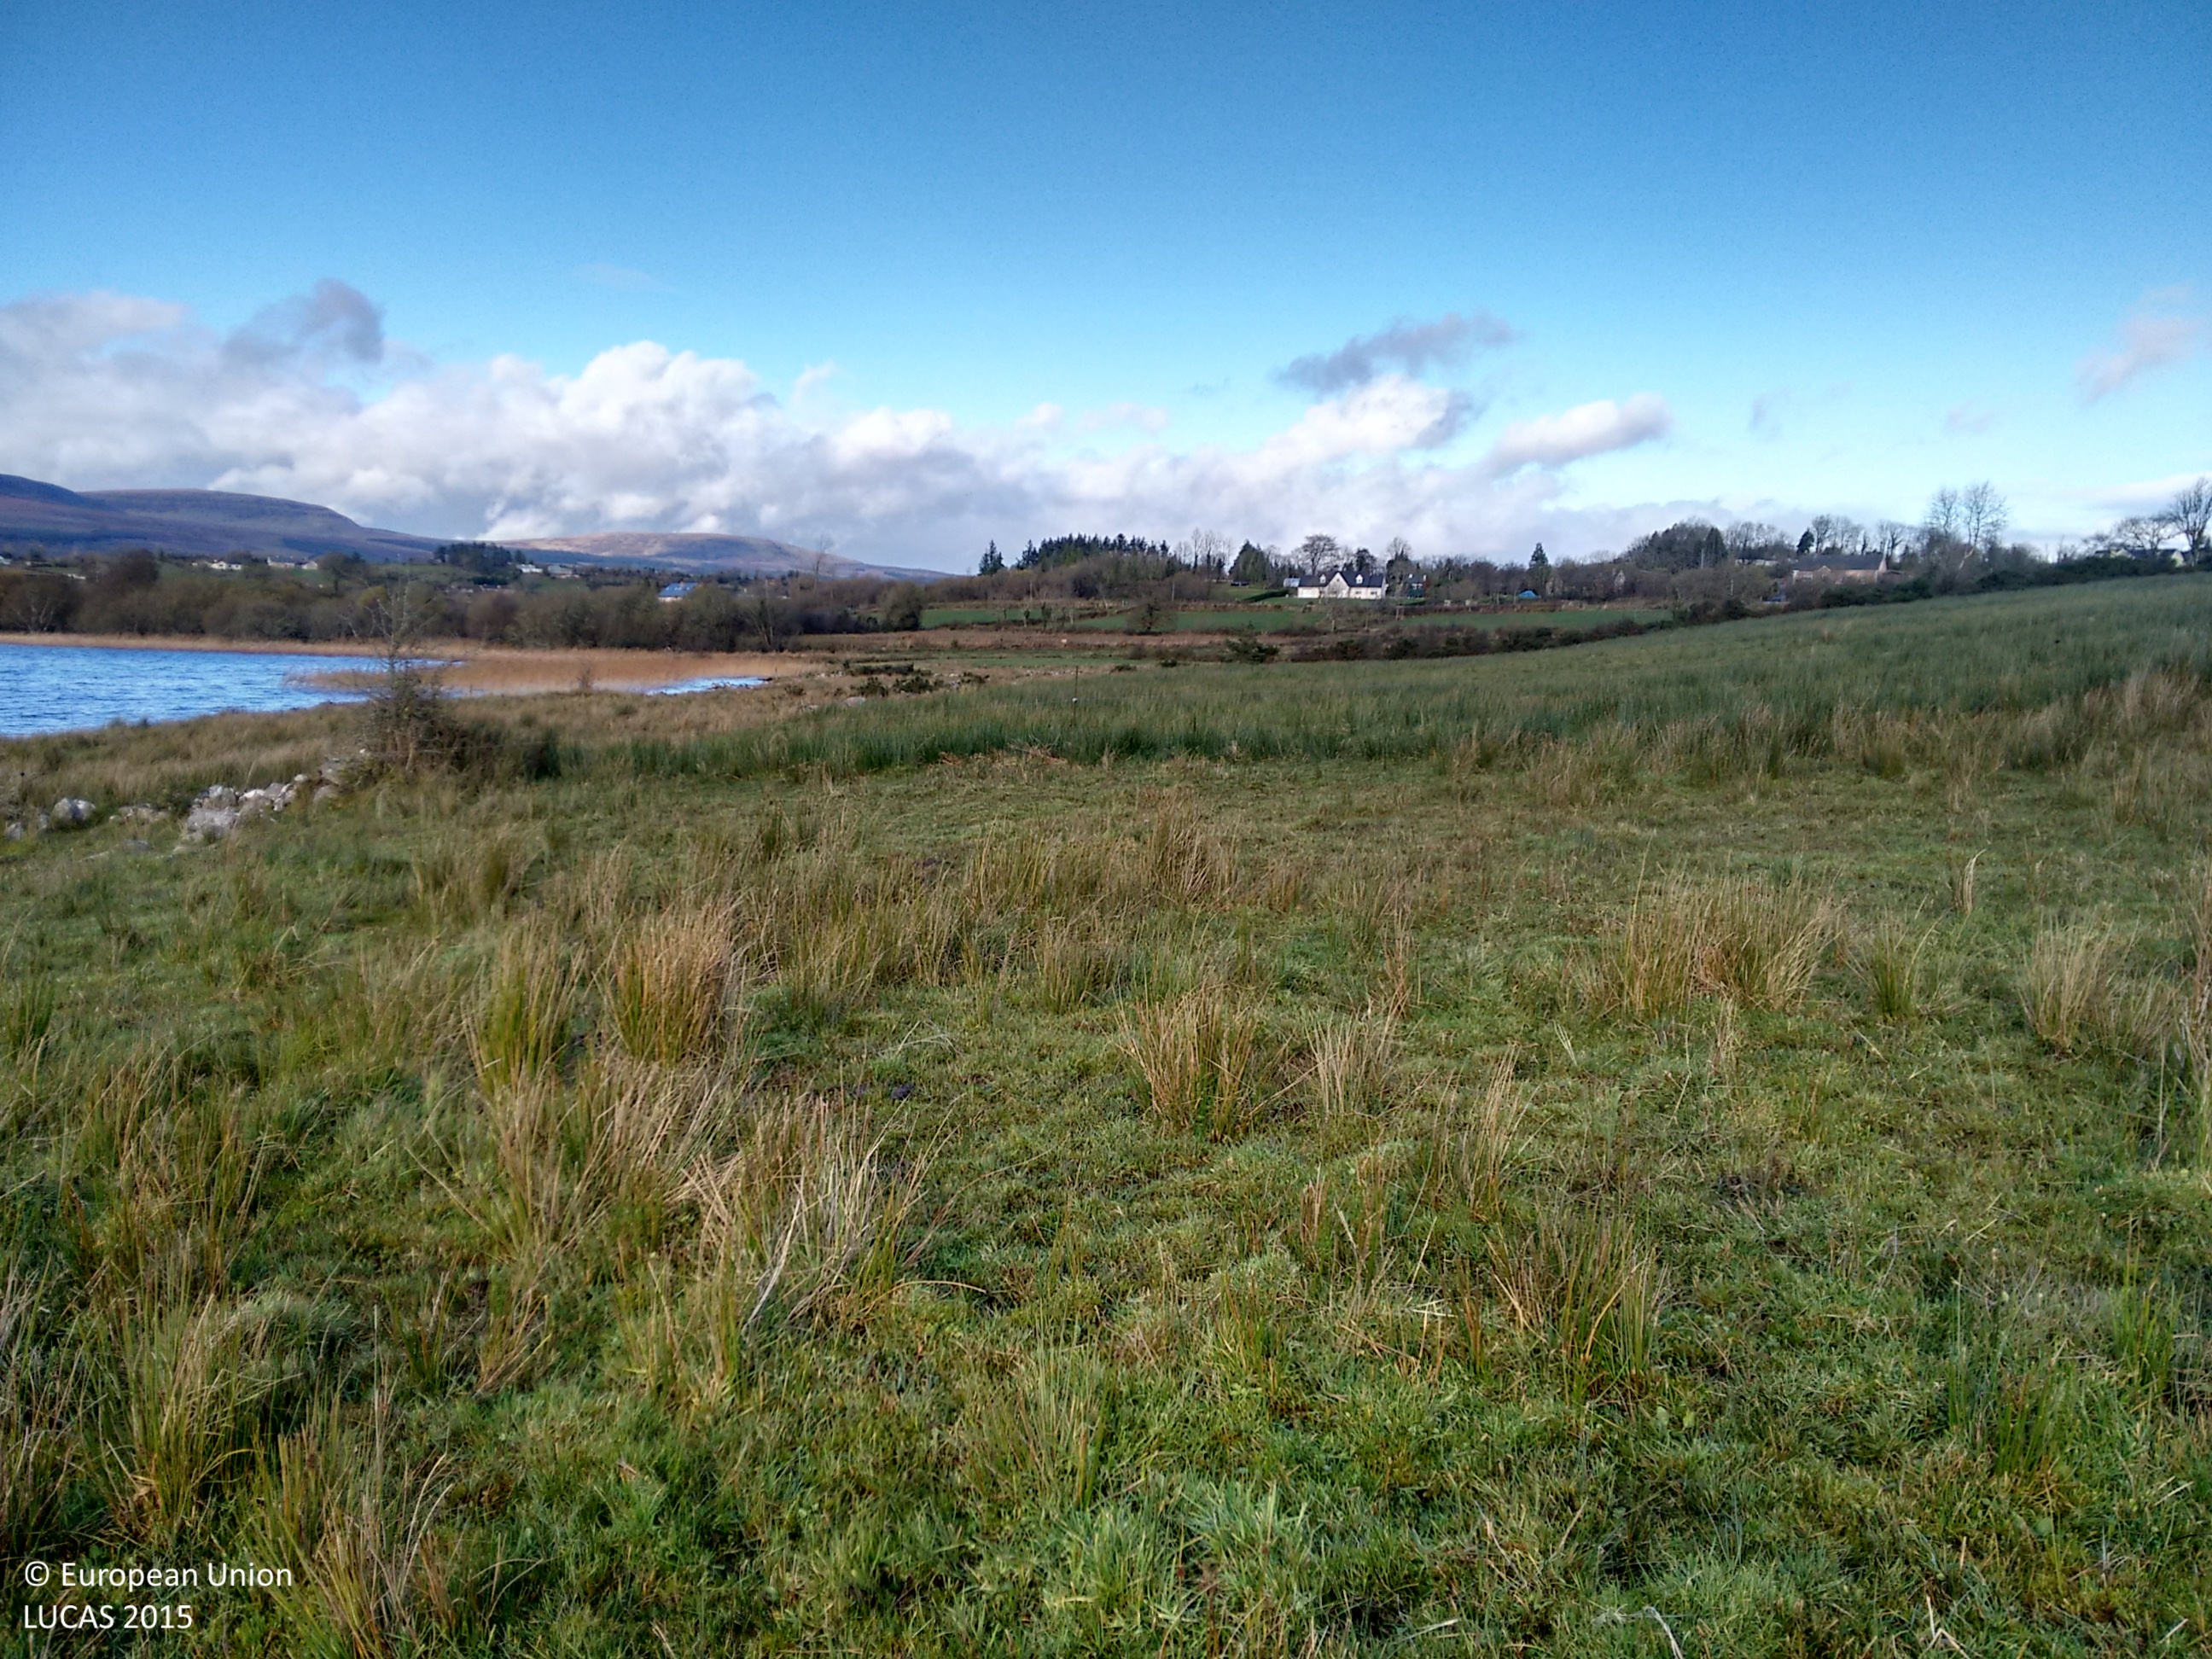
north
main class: Grassland
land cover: Grassland without tree/shrub cover
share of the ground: > 75 %
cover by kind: herbaceous plants 100 %
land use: Agriculture (excluding fallow land and kitchen gardens)
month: November
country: IE
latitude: 54.0445
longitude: -7.9014
